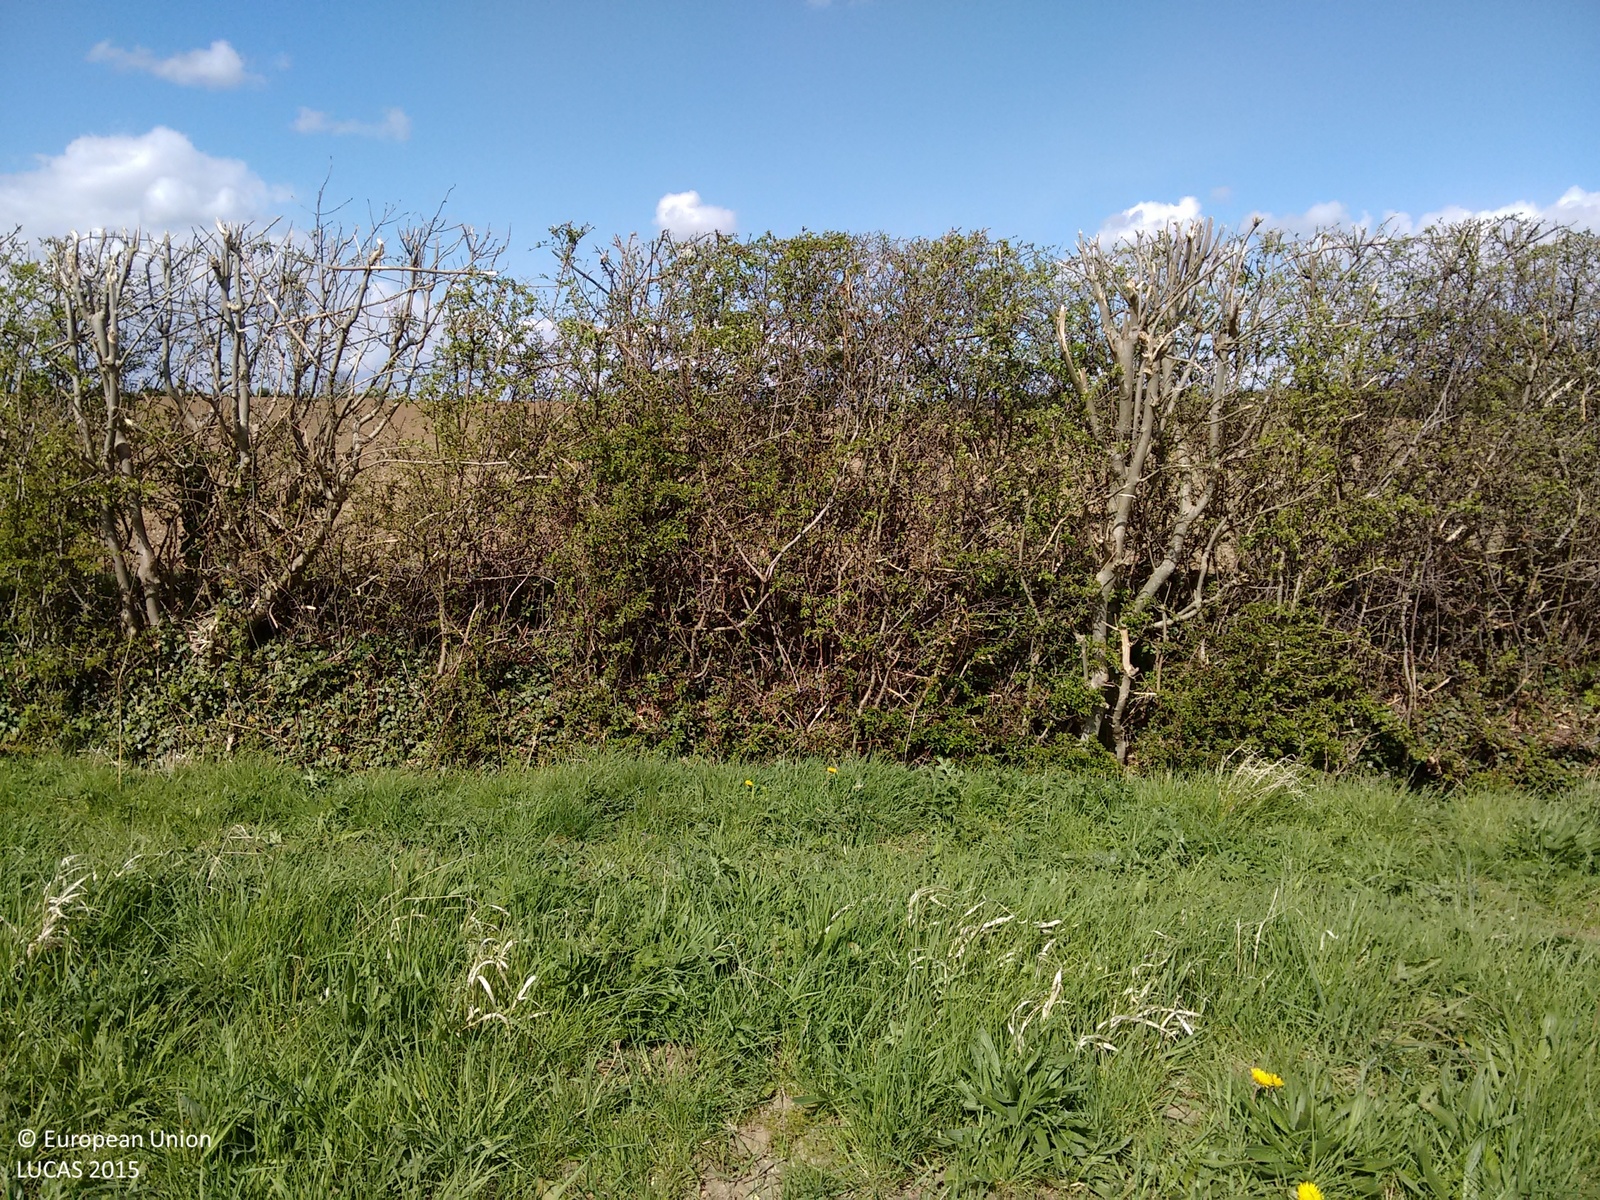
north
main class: Grassland
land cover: Grassland without tree/shrub cover
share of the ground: > 75 %
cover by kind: herbaceous plants 100 %
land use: Road transport
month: April
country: GB
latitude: 53.1575
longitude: -0.1281
